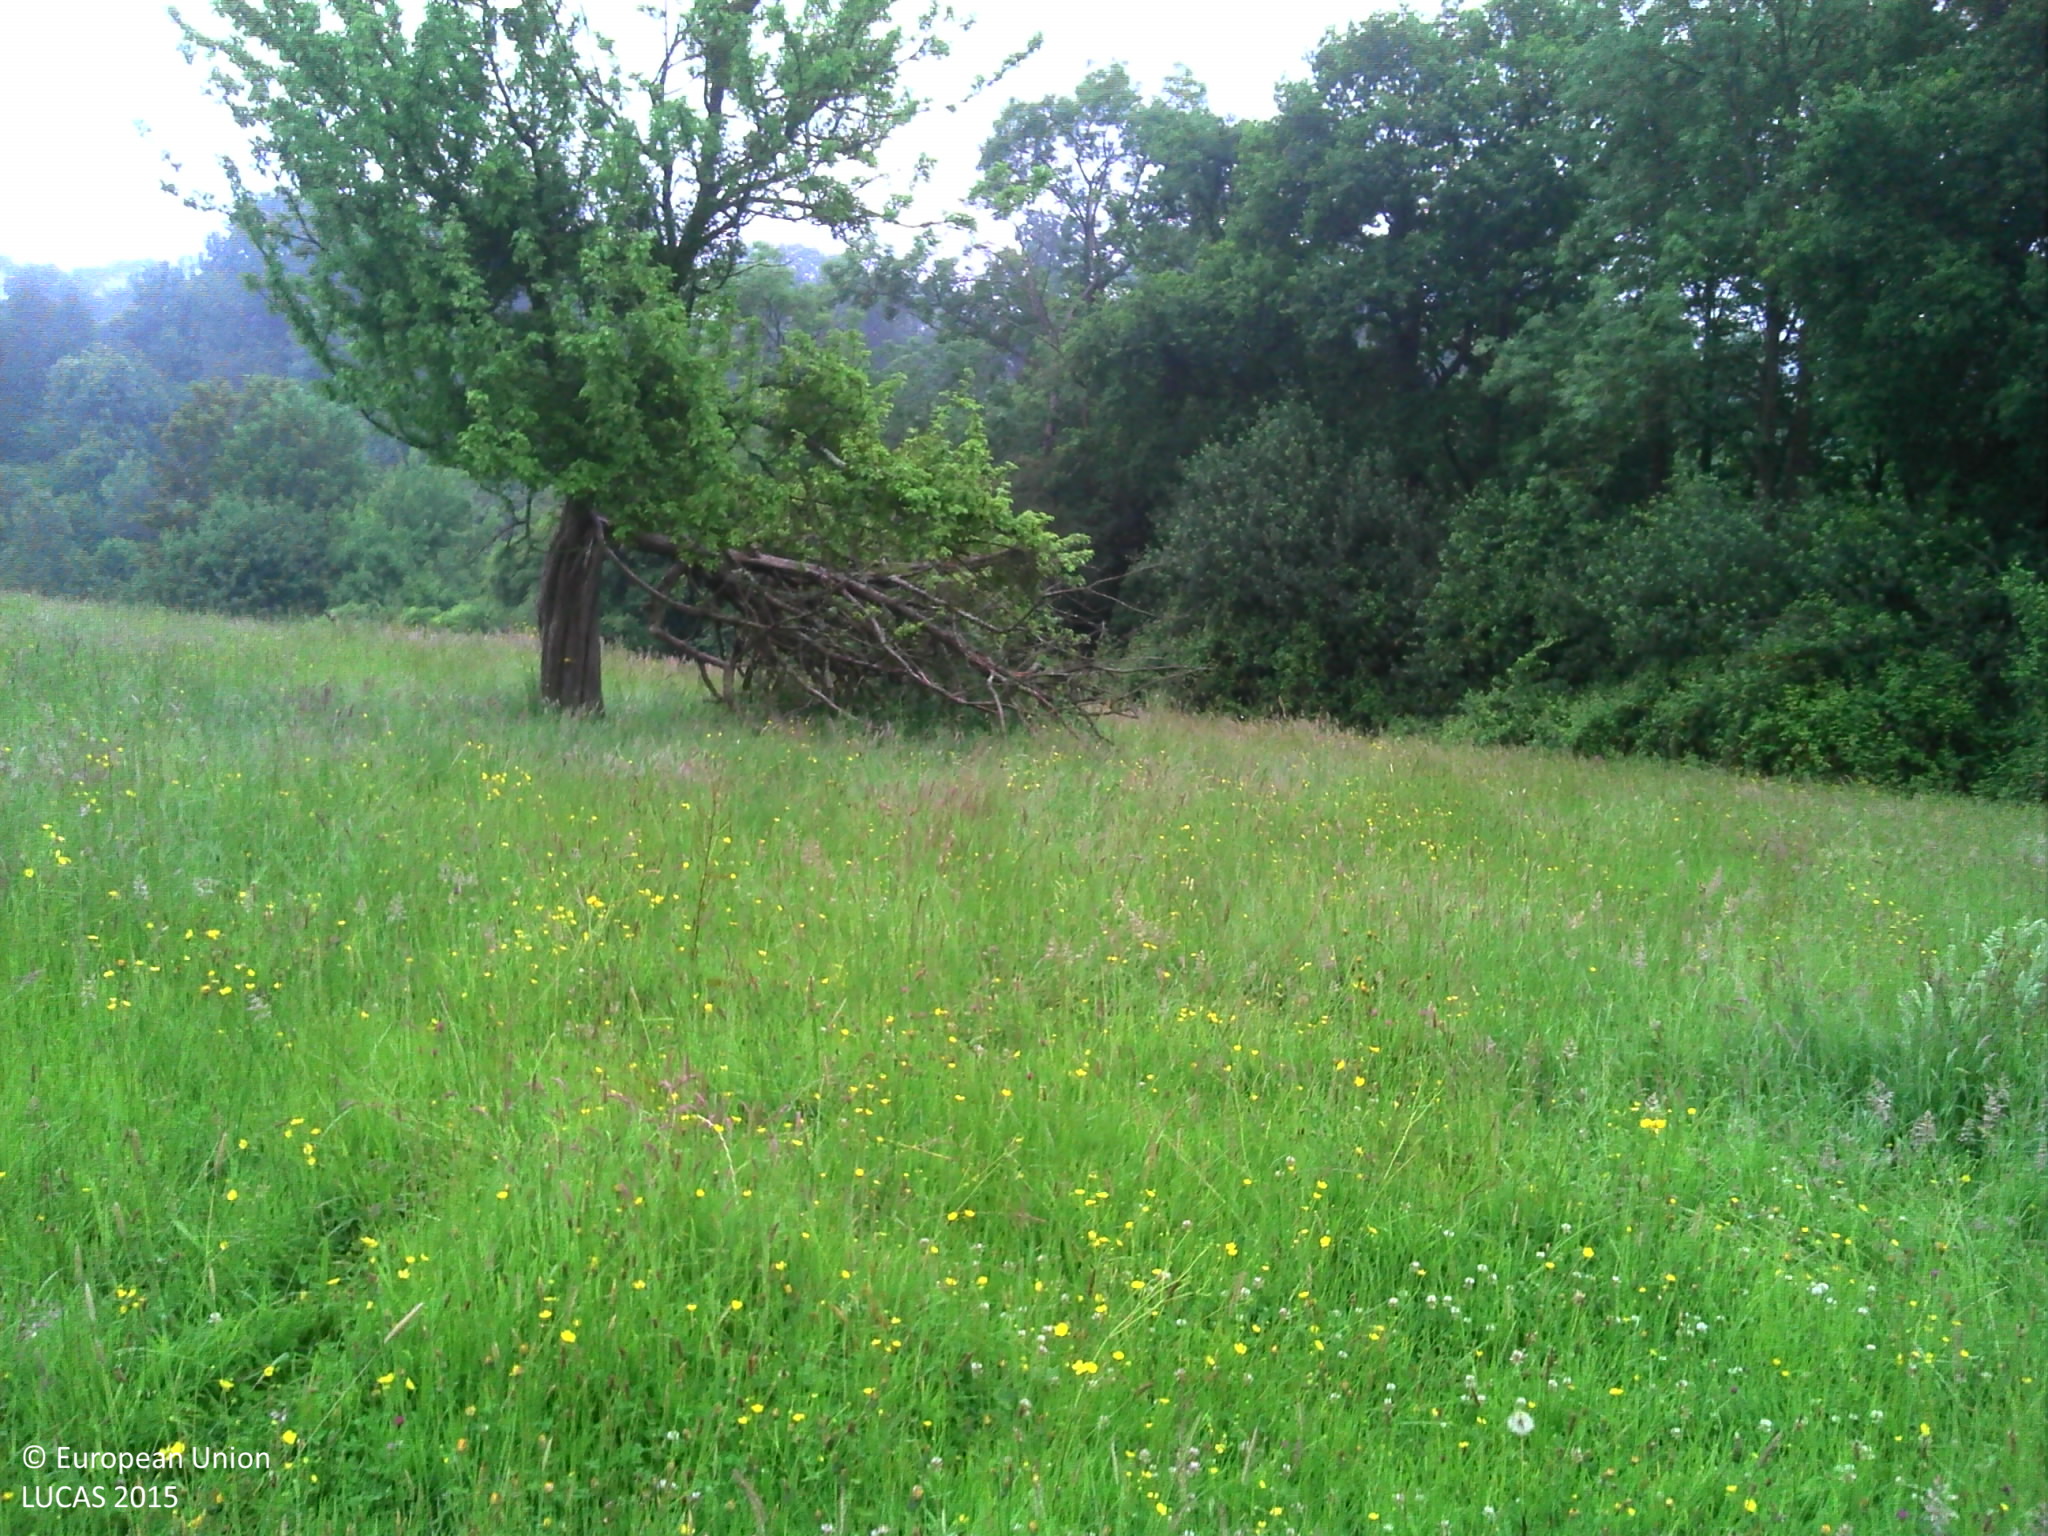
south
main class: Grassland
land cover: Grassland with sparse tree/shrub cover
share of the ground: > 75 %
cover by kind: herbaceous plants 95 %, broadleaved forest trees 5 %
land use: Agriculture (excluding fallow land and kitchen gardens)
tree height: > 5 m
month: June
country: FR
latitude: 49.2395
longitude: 0.0388
